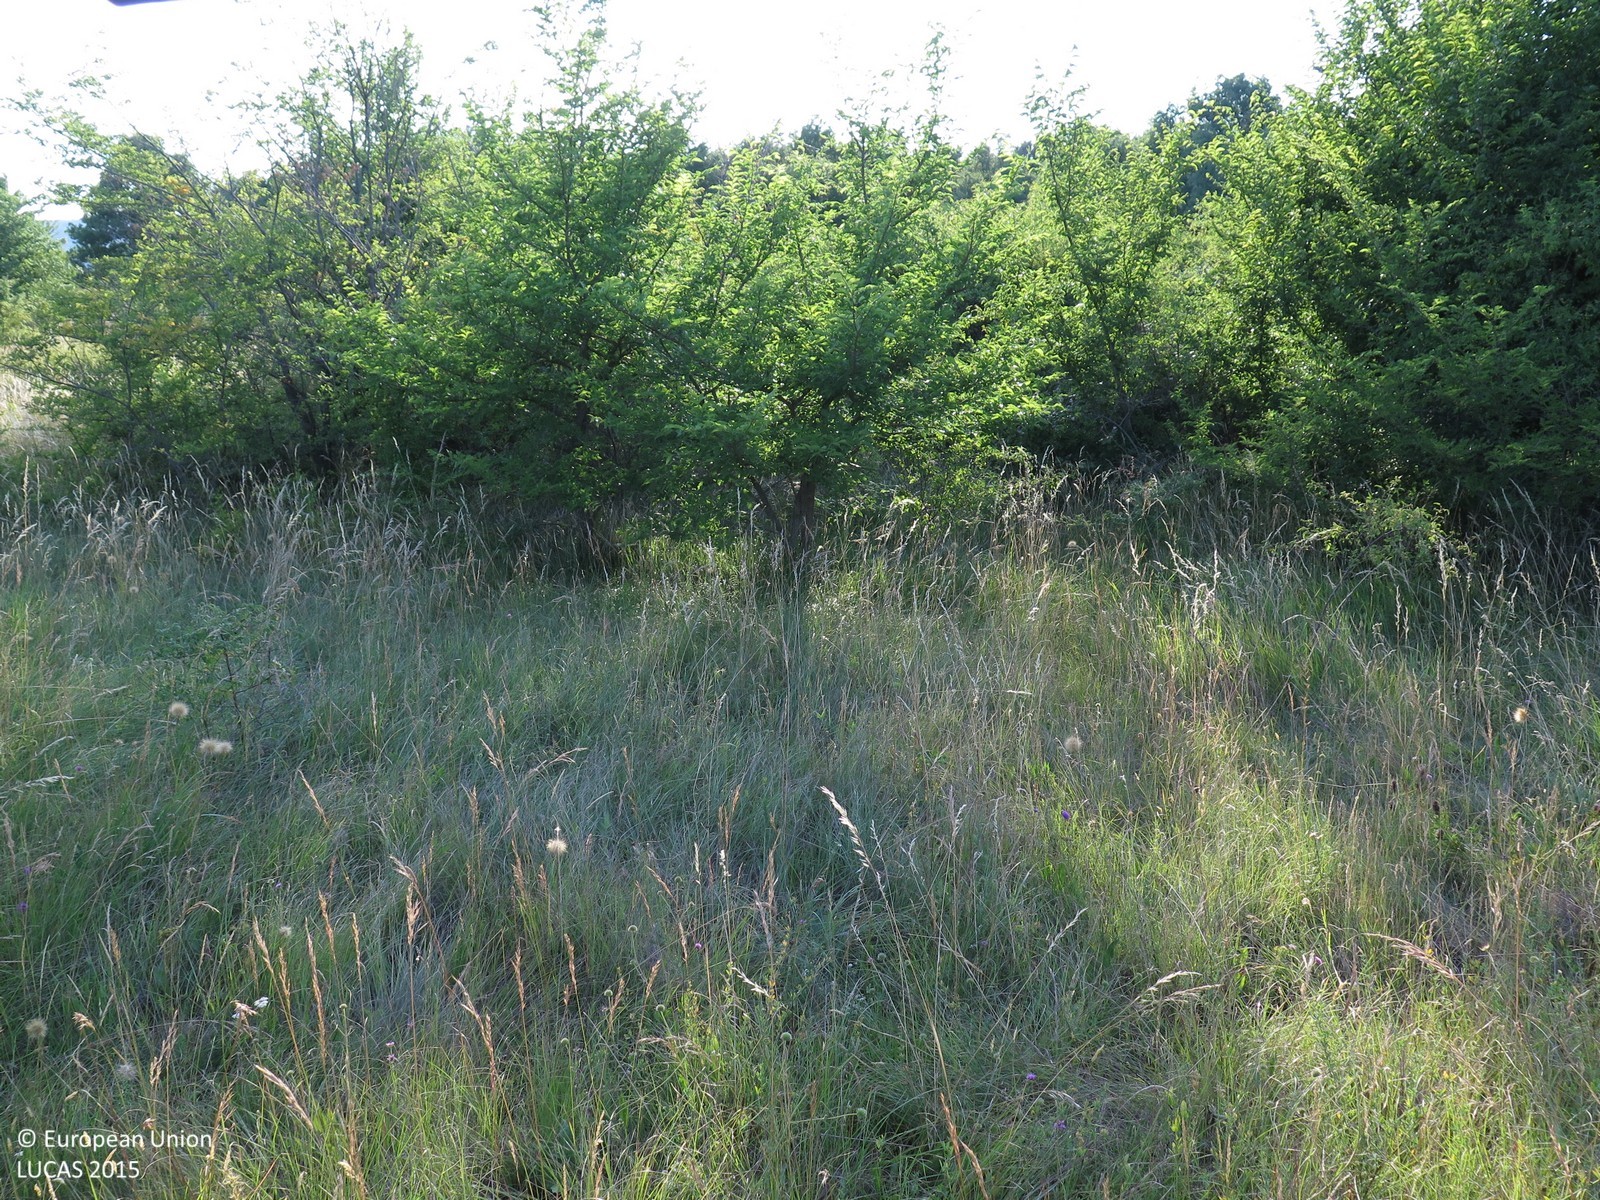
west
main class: Grassland
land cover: Grassland with sparse tree/shrub cover
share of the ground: > 75 %
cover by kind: herbaceous plants 90 %, broadleaved forest trees 5 %, shrubs 5 %
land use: Abandoned areas
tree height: > 5 m
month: June
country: HR
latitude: 45.1200
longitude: 14.0498
